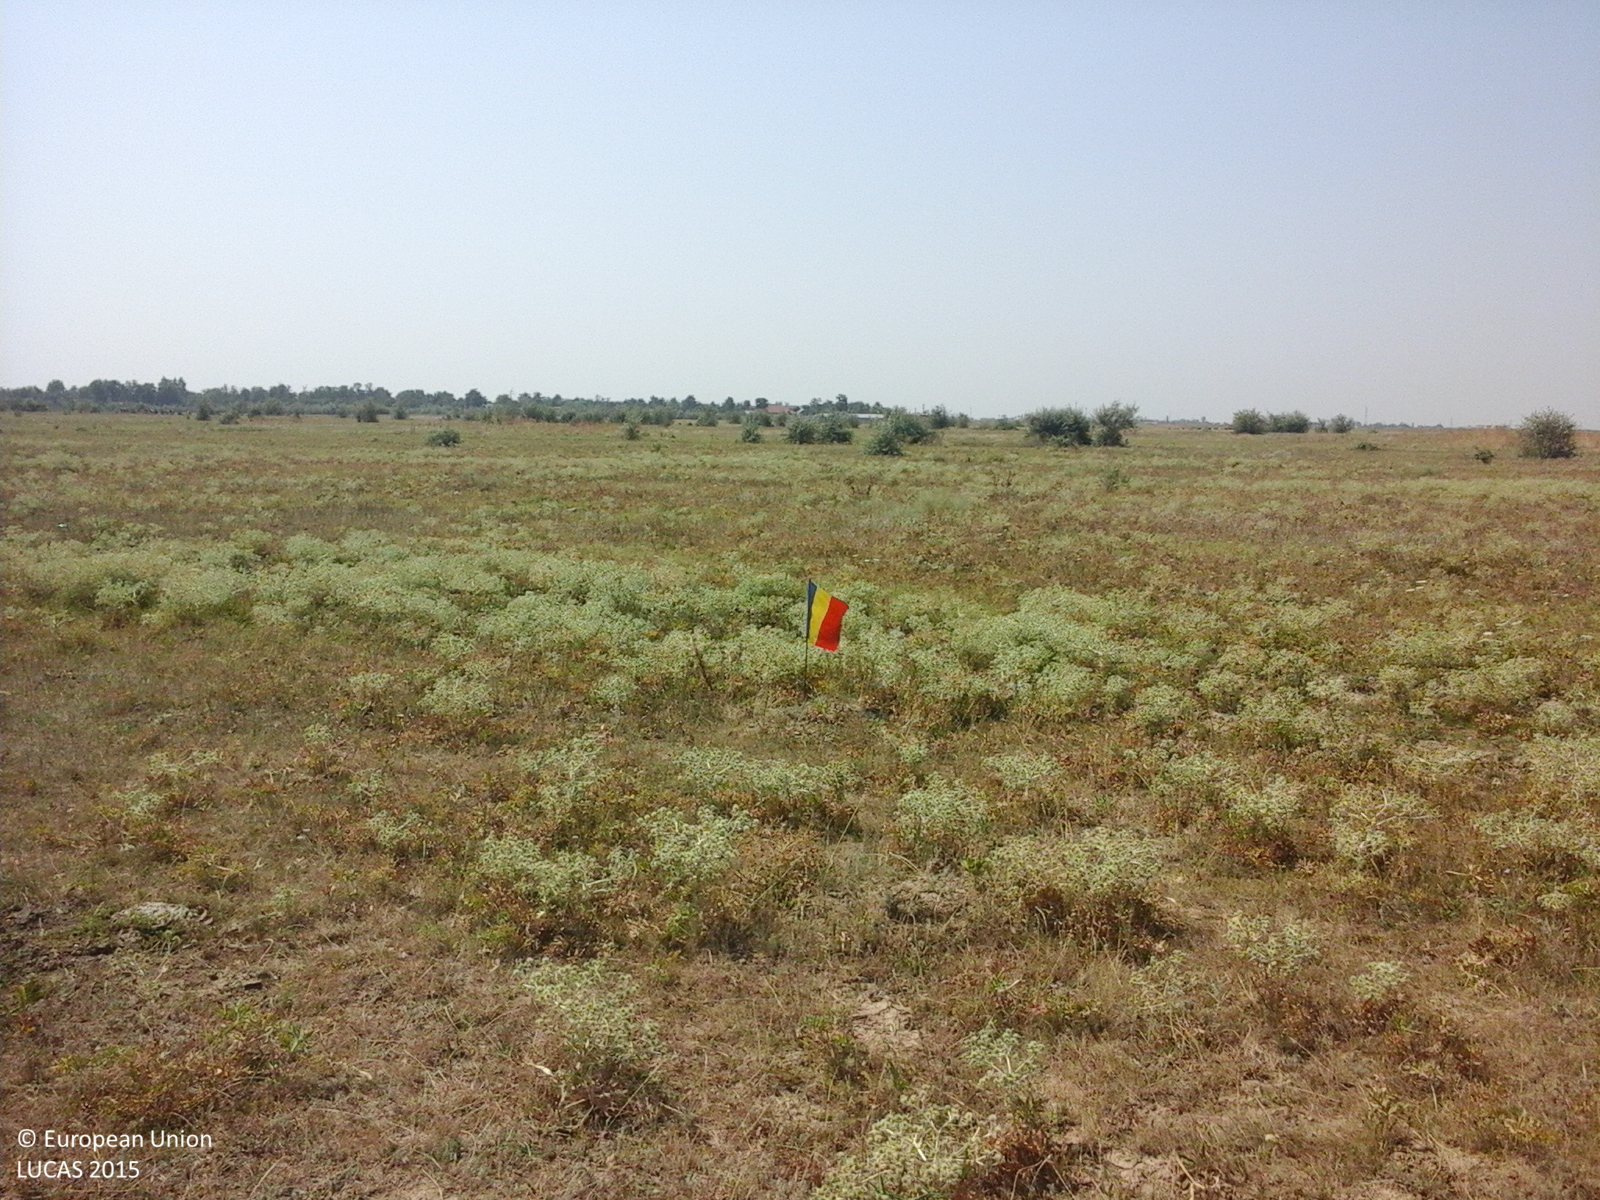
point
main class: Grassland
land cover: Spontaneously vegetated surfaces
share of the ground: > 75 %
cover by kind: herbaceous plants 100 %
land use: Agriculture (excluding fallow land and kitchen gardens)
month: August
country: RO
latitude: 45.1133
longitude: 27.2905
